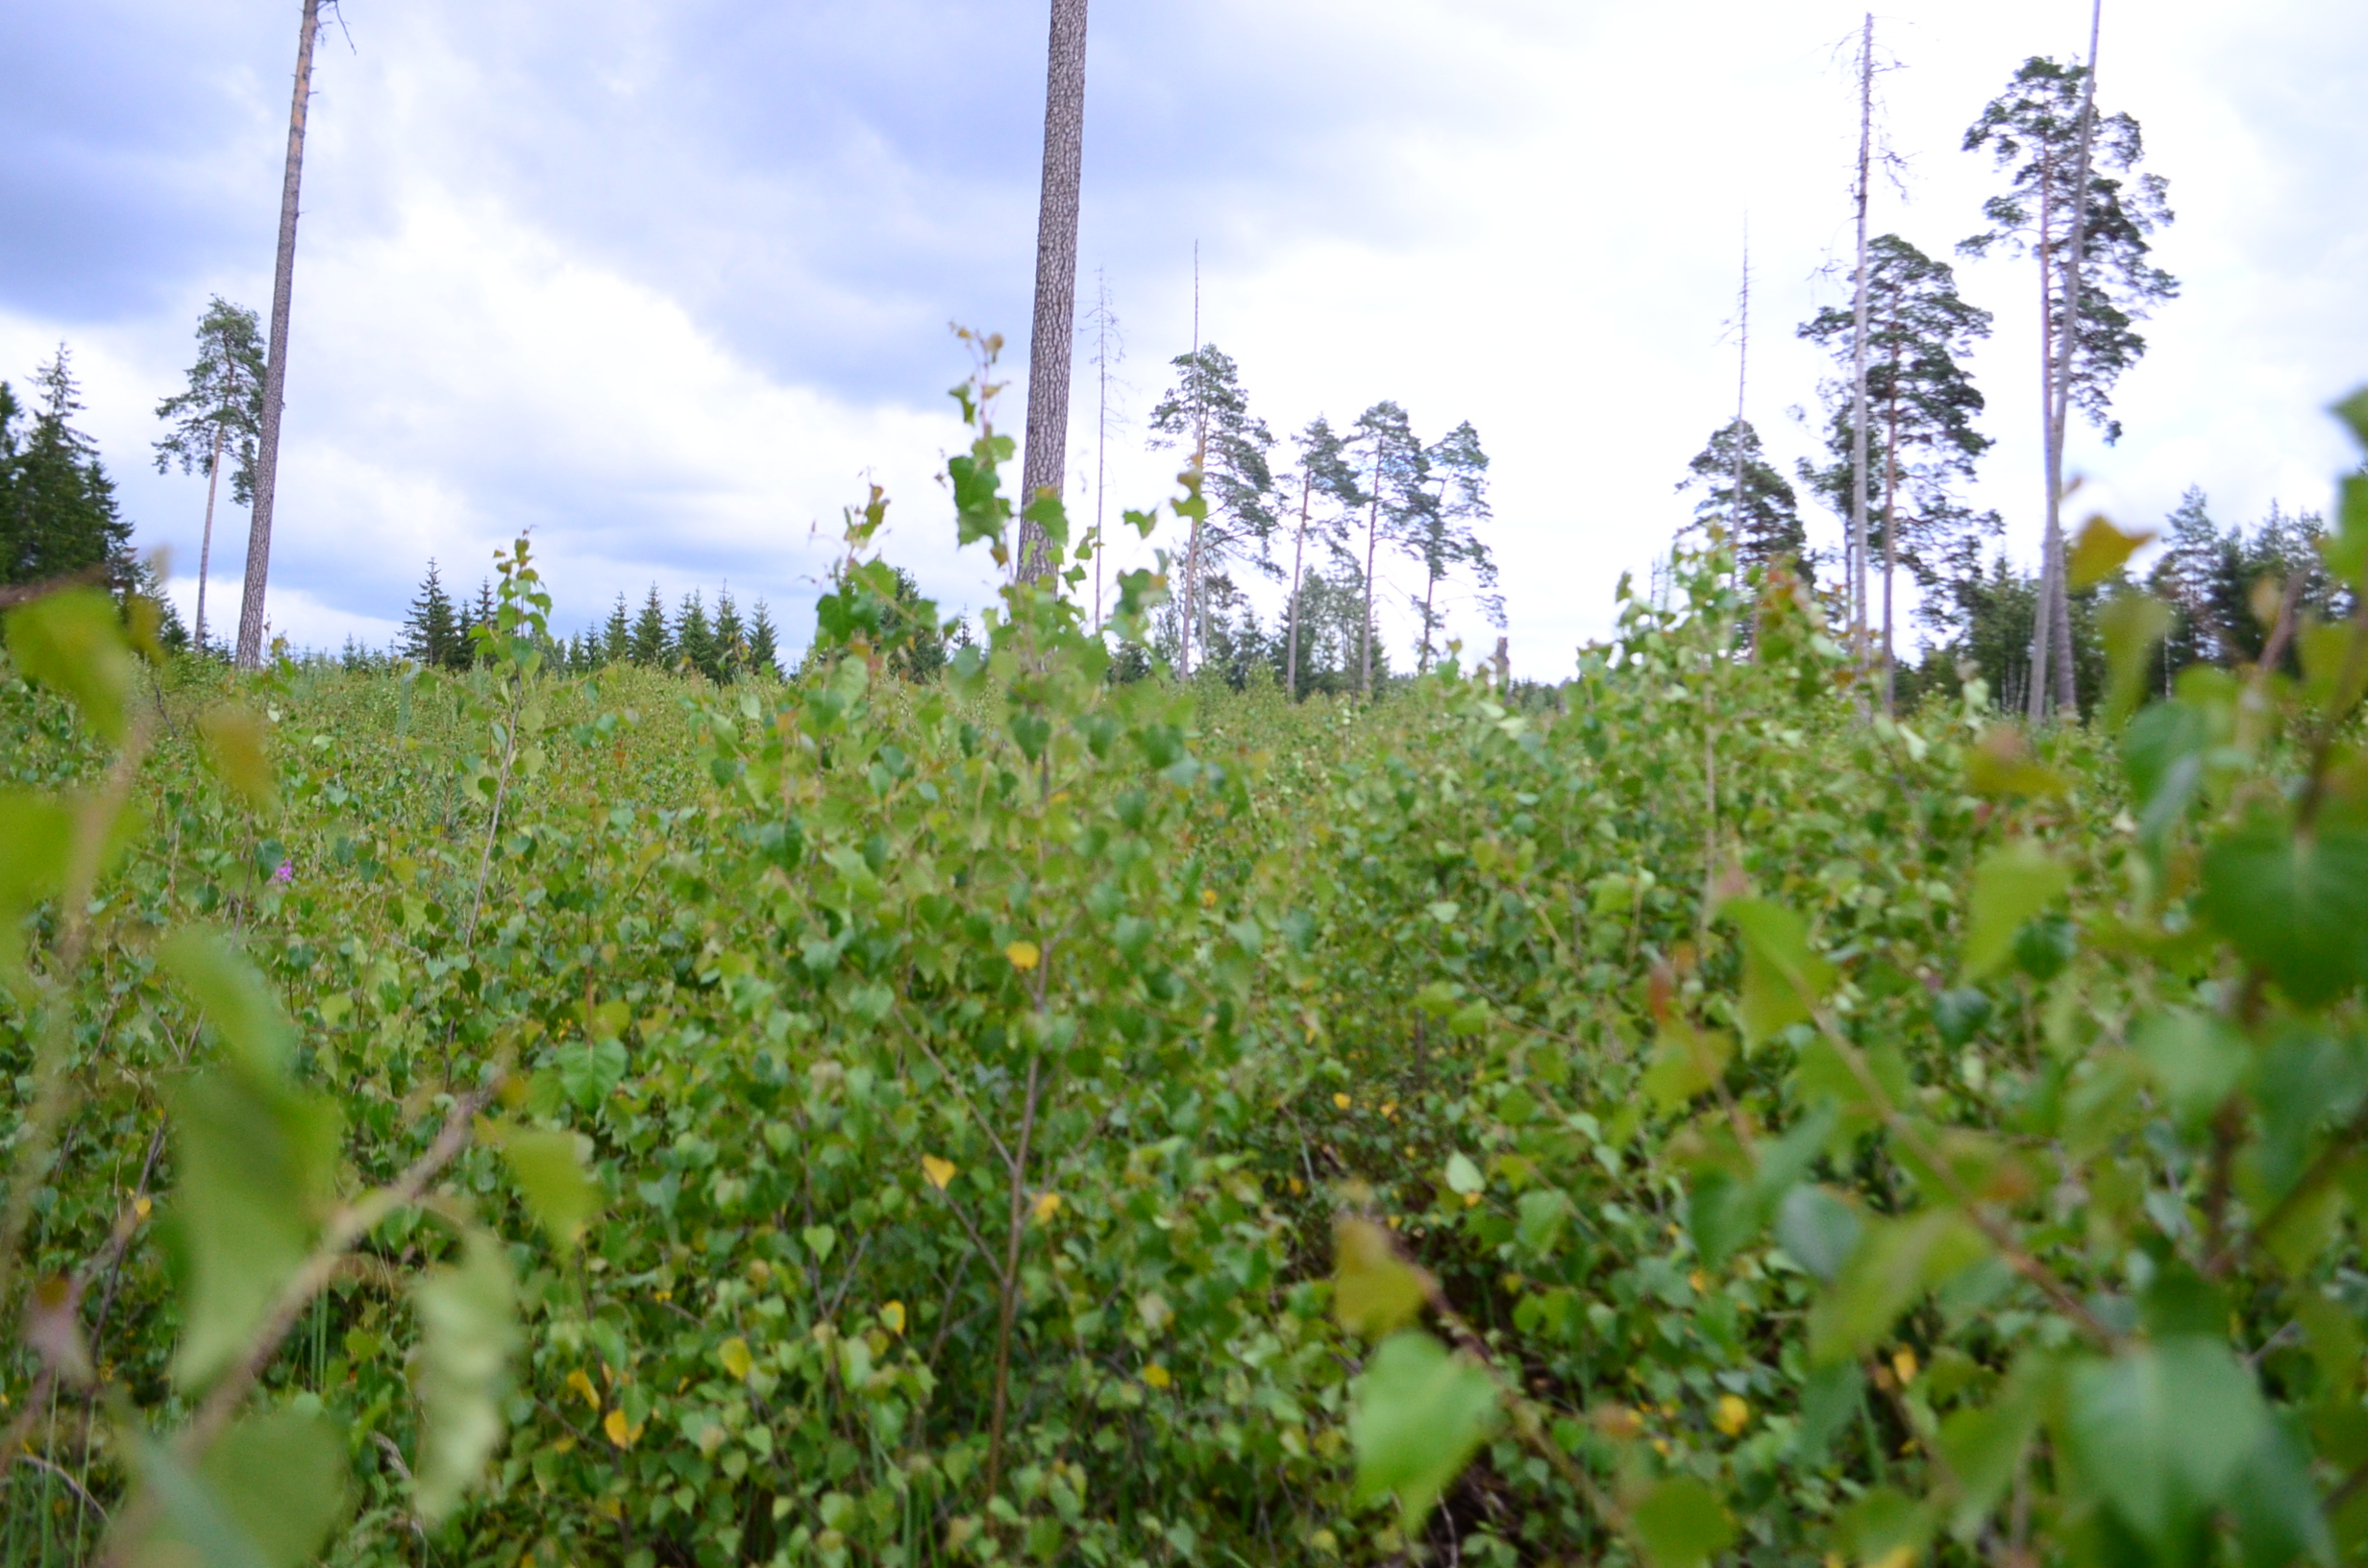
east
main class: Woodland
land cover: Pine dominated mixed woodland
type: hemiboreal forest and nemoral coniferous forest and mixed broadleaved-coniferous forest
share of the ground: 50 - 75 %
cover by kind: broadleaved forest trees 30 %, shrubs 30 %, coniferous forest trees 25 %, herbaceous plants 15 %
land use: Forestry
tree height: < 5 m
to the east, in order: Pine dominated mixed woodland; Other mixed woodland; Shrubland with sparse tree cover; Spruce dominated mixed woodland
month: July
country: LV
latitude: 57.1326
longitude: 22.3944
